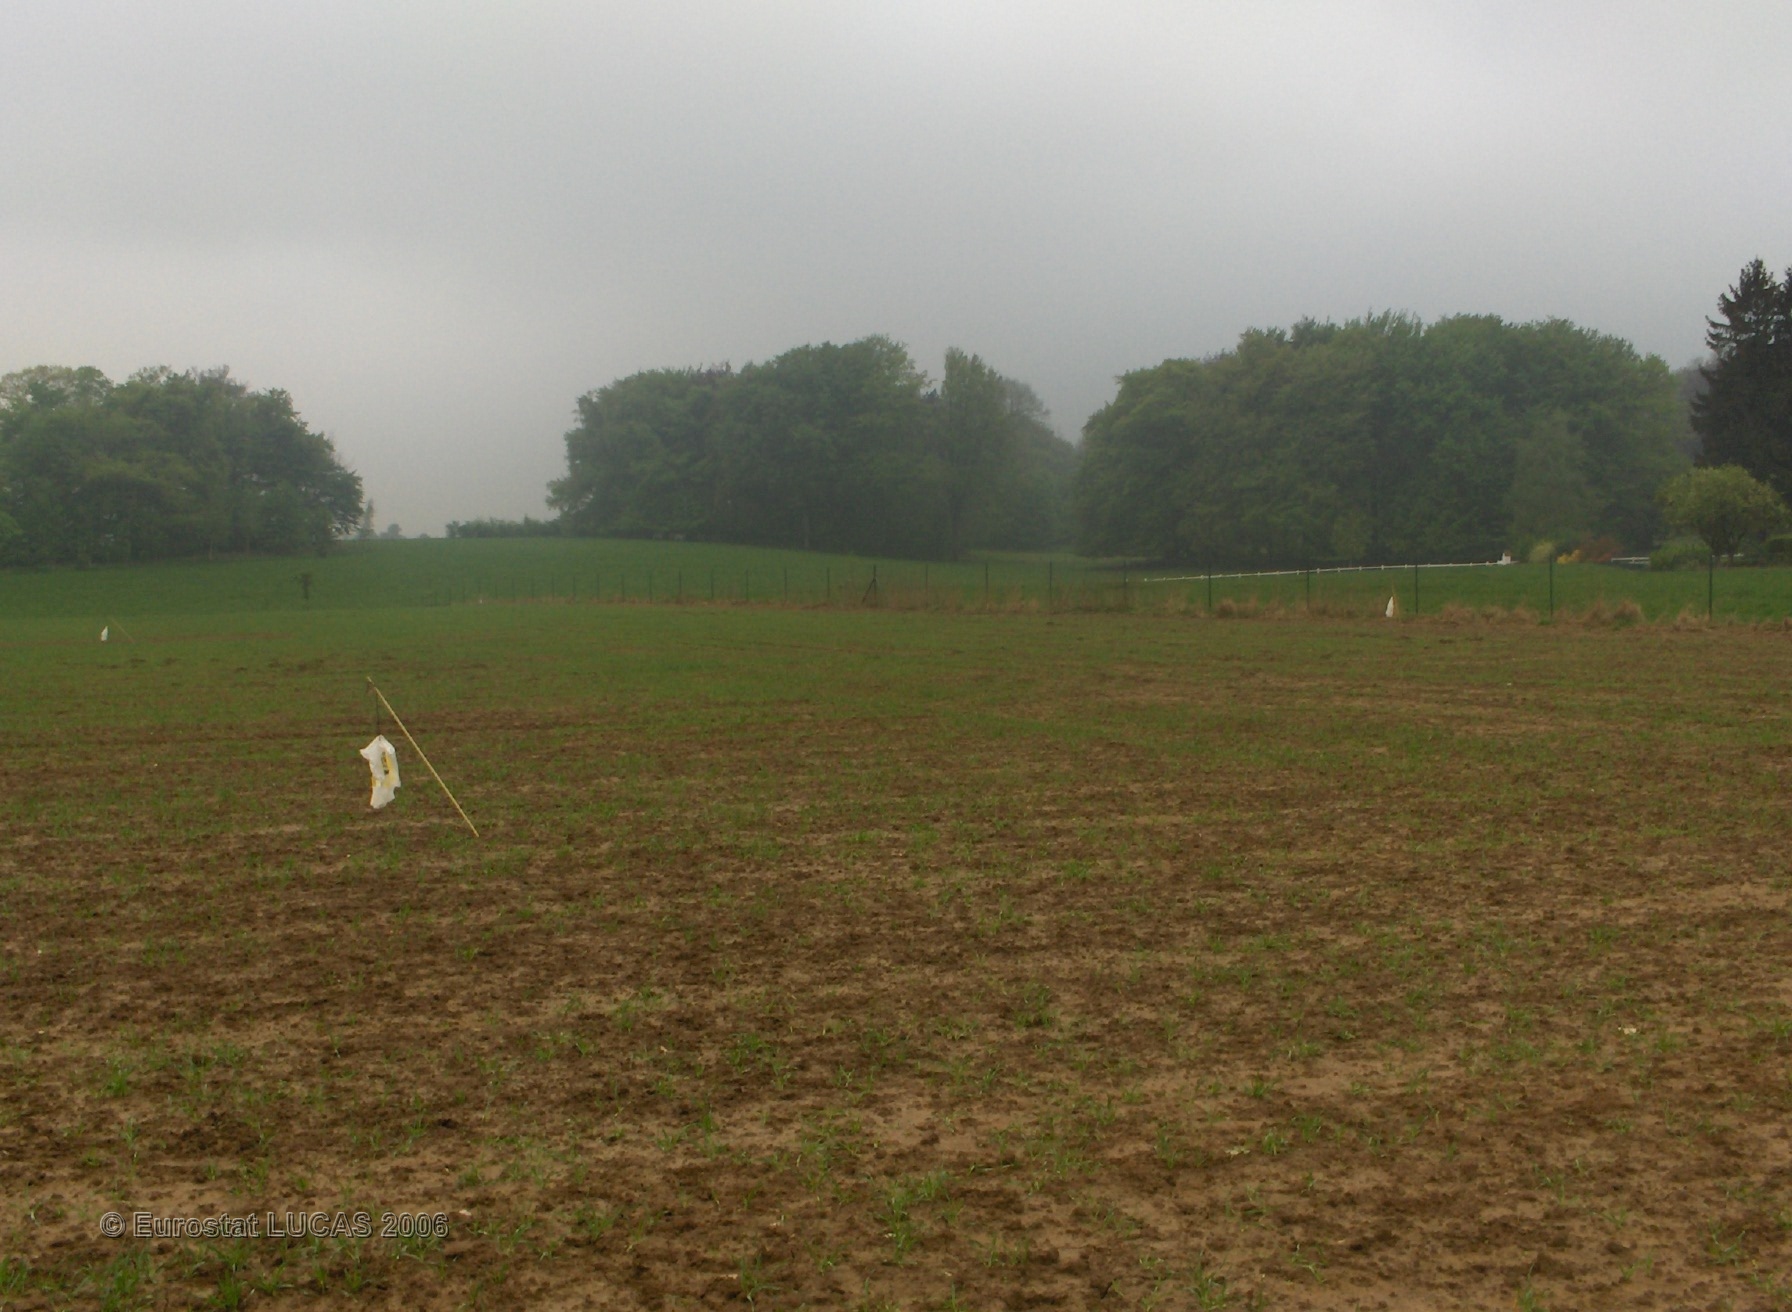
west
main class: Cropland
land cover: Barley
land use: Agriculture (excluding fallow land and kitchen gardens)
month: May
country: BE
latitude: 50.5372
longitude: 4.4790
